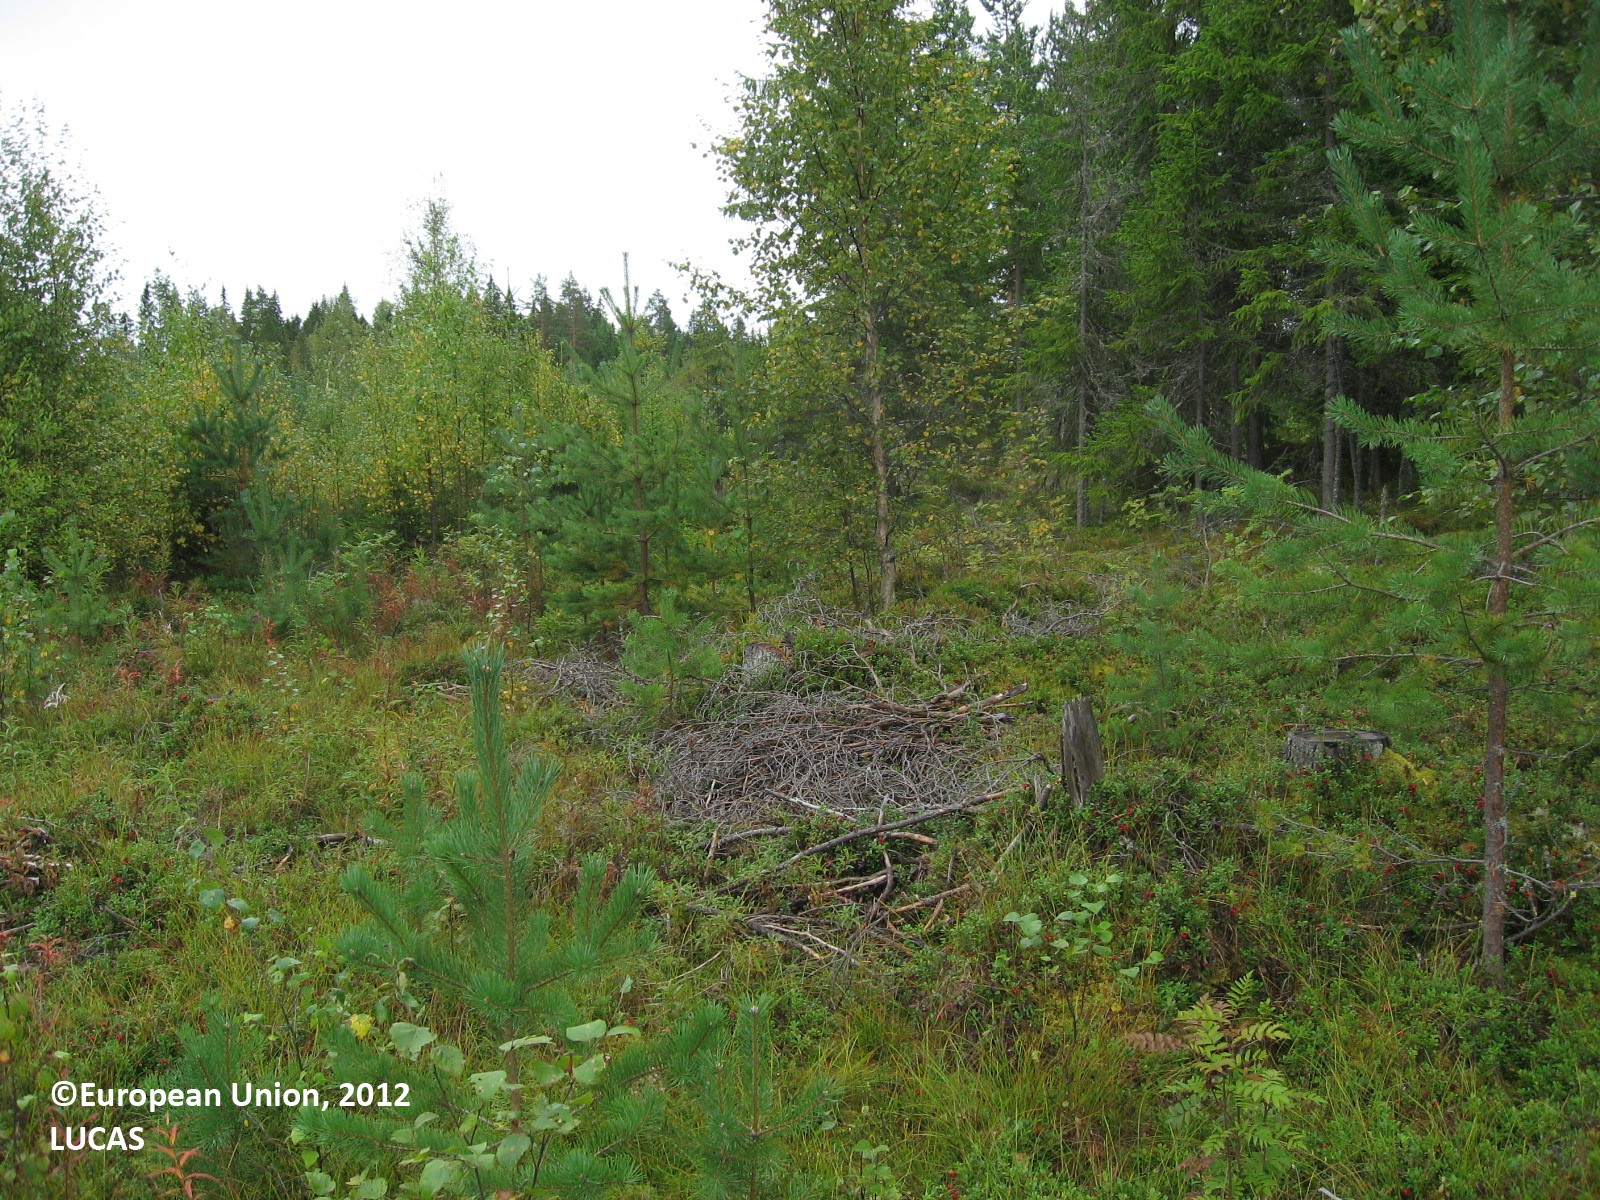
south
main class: Woodland
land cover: Pine dominated mixed woodland
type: boreal forest
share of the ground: 50 - 75 %
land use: Forestry
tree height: < 5 m
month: August
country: FI
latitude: 61.4877
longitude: 24.8095
